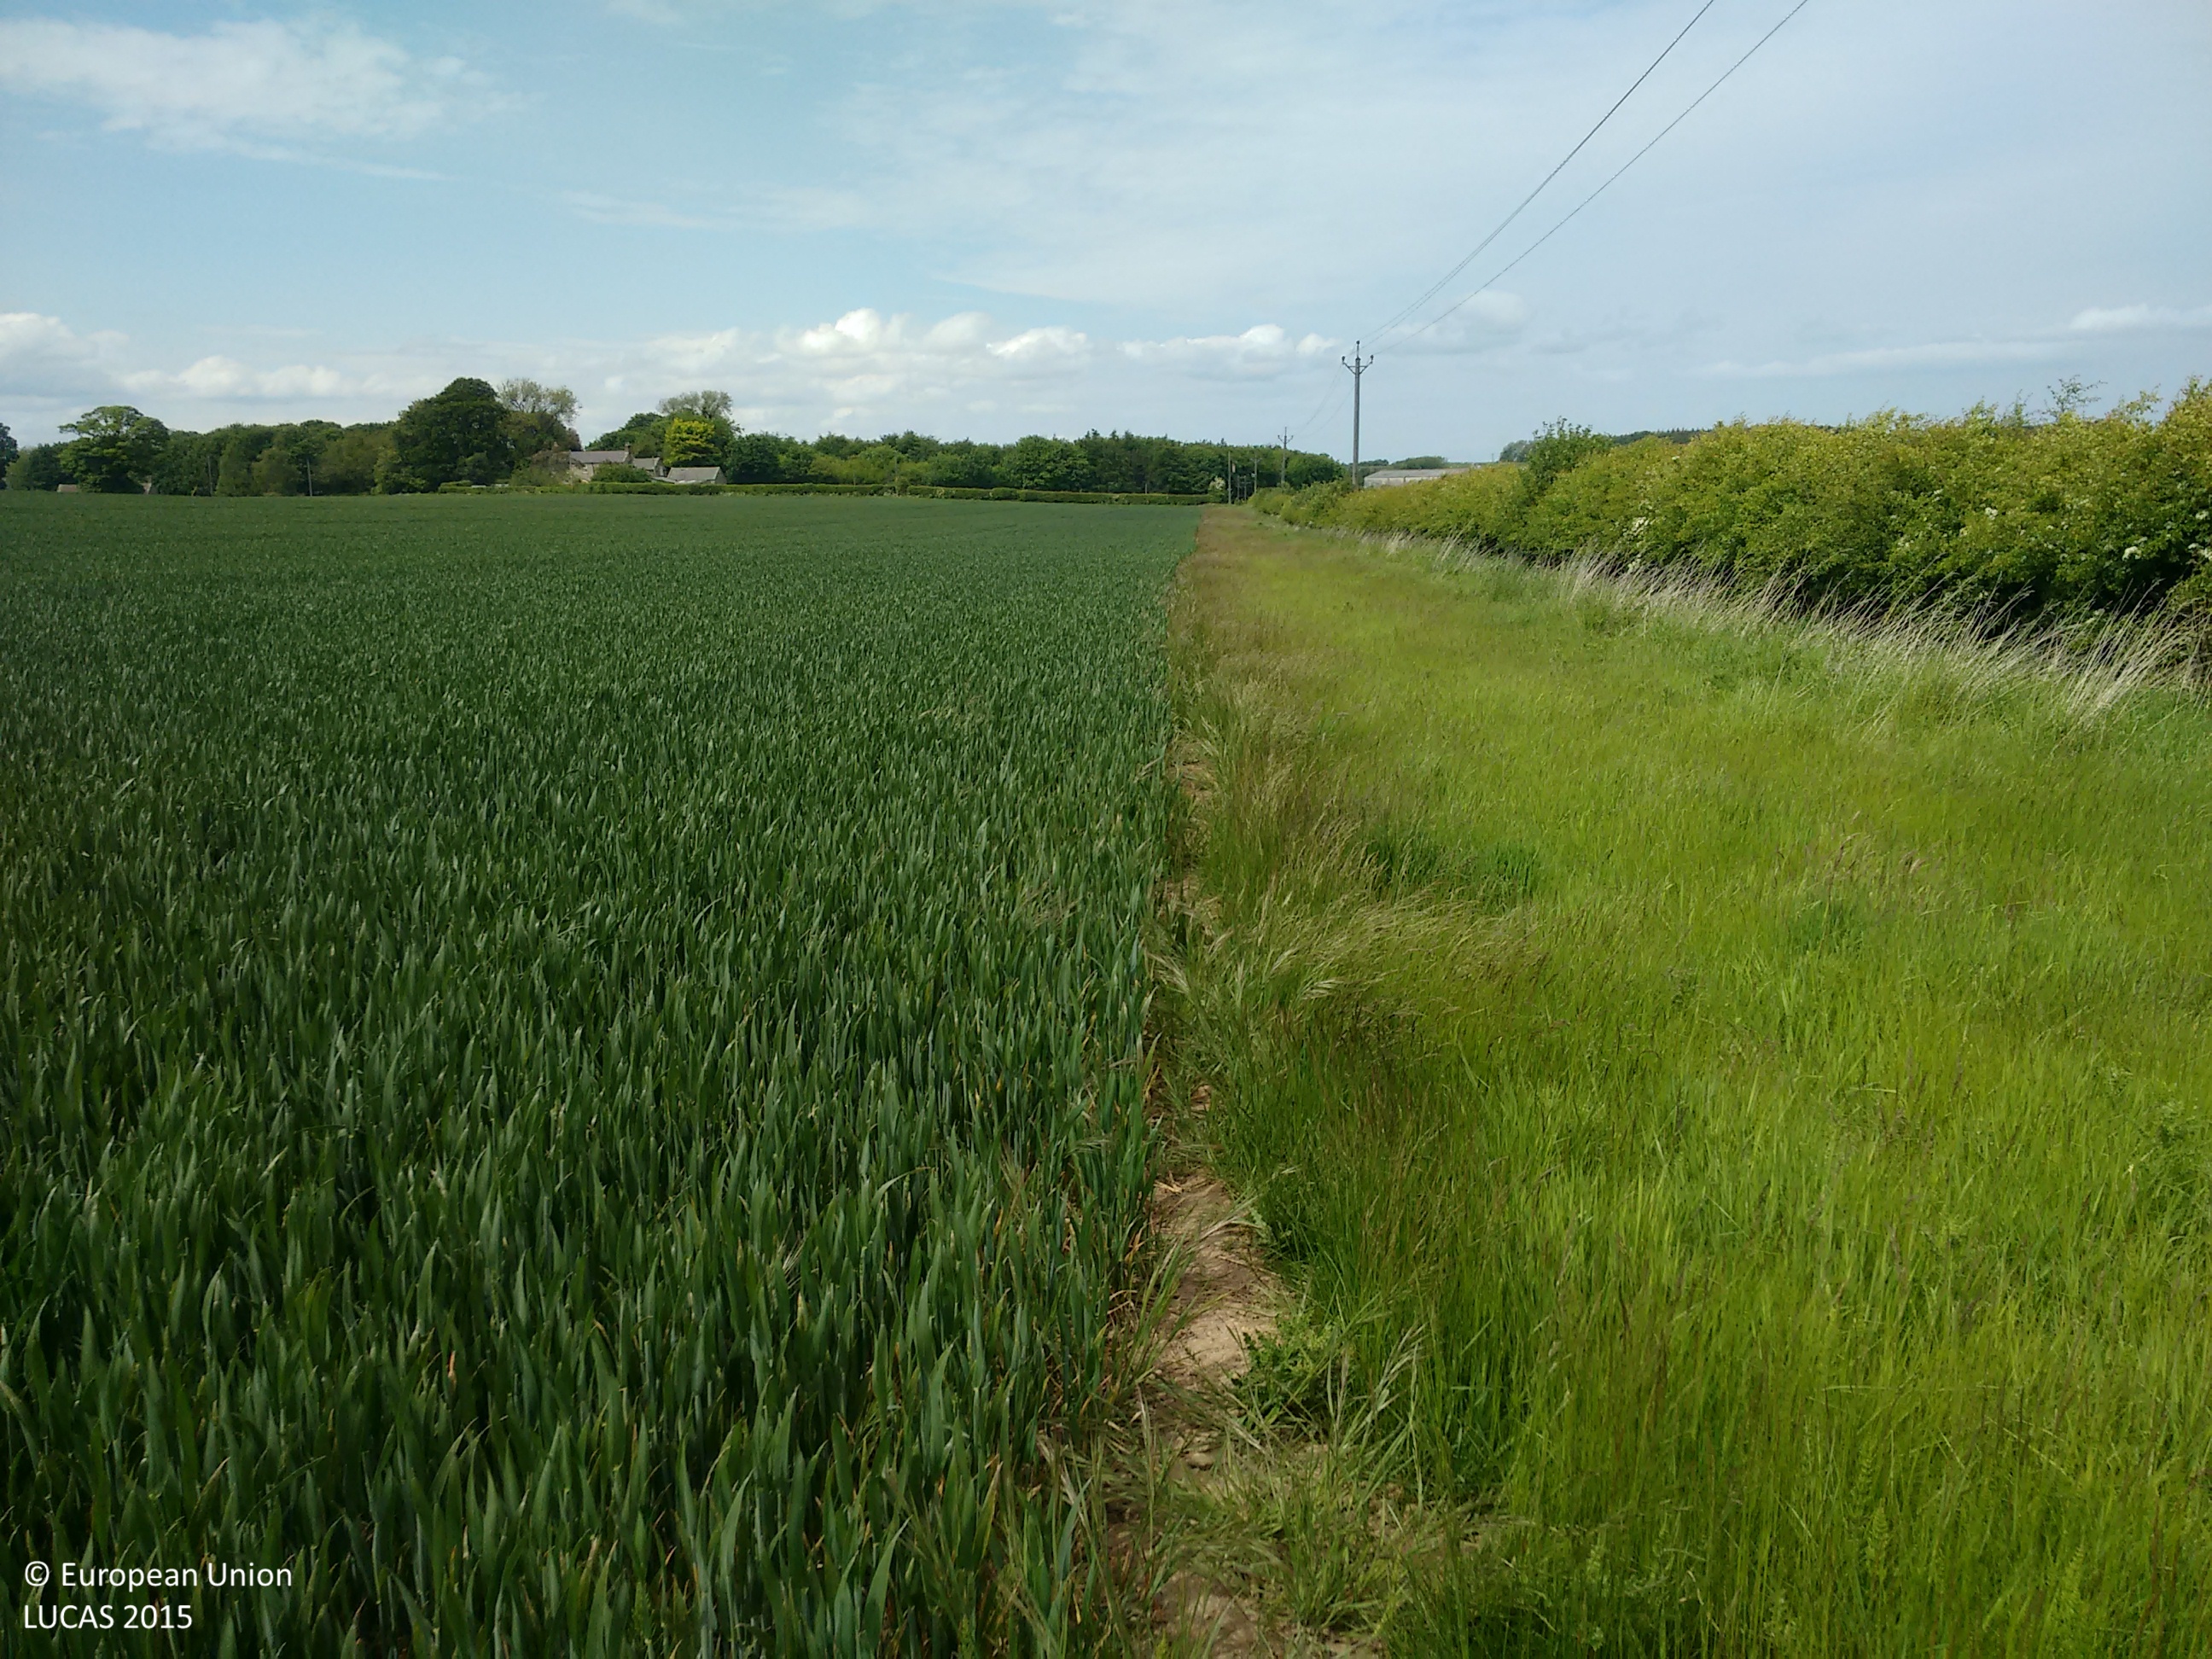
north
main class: Cropland
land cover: Common wheat
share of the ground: > 75 %
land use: Agriculture (excluding fallow land and kitchen gardens)
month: June
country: GB
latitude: 55.4383
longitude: -1.6336
